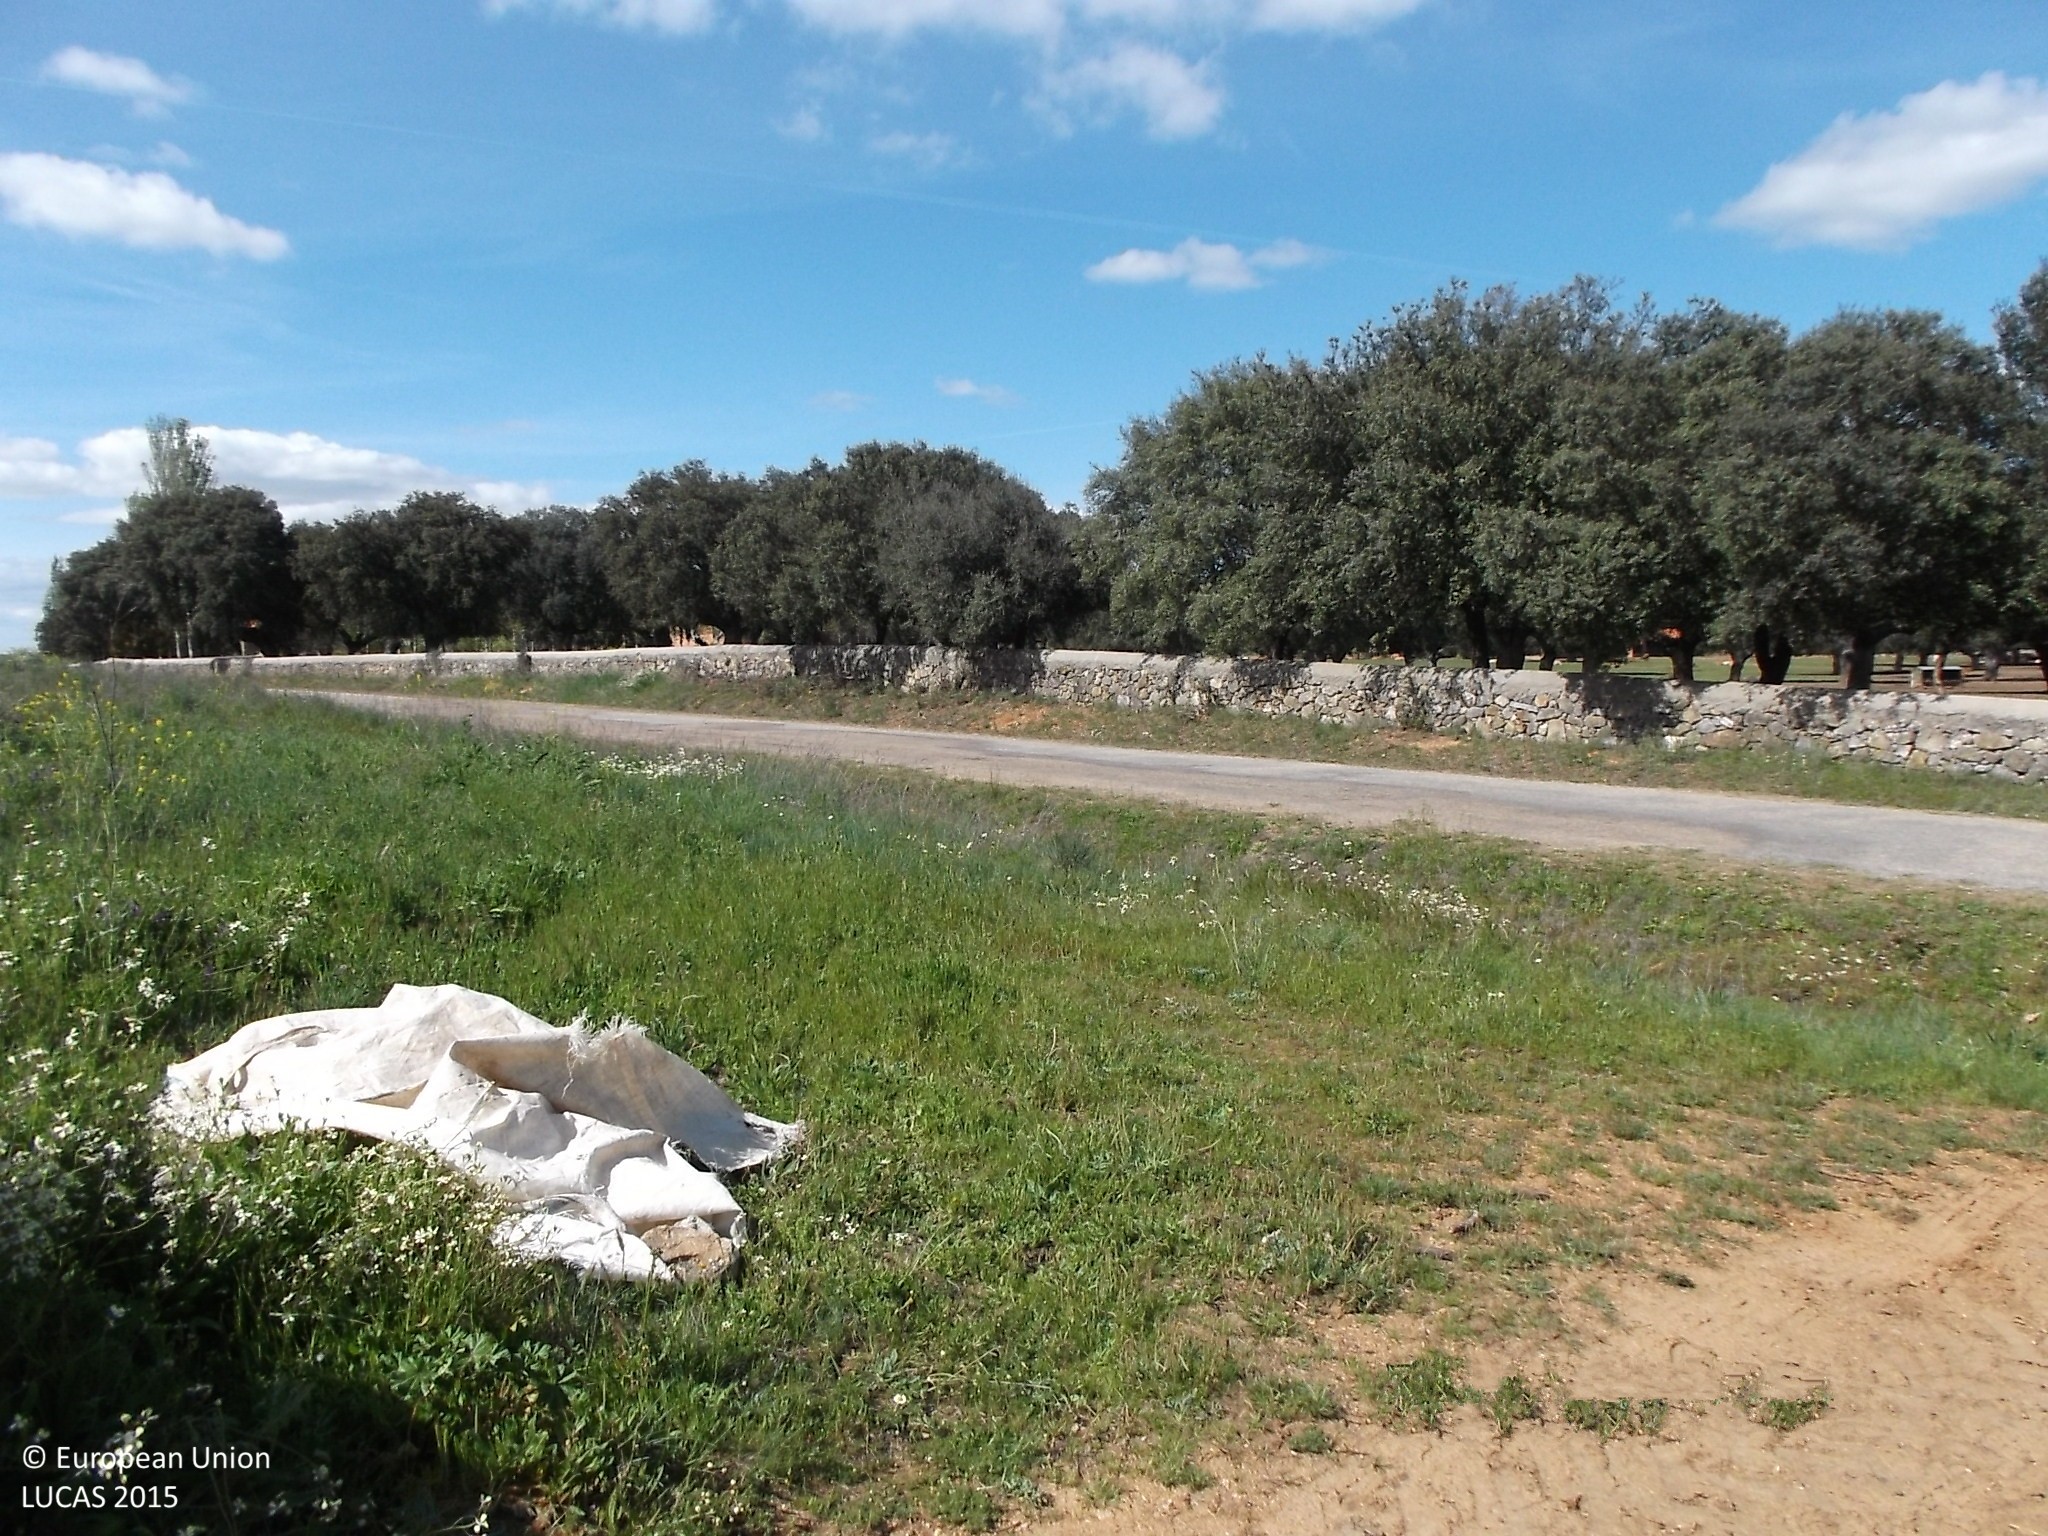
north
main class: Woodland
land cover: Broadleaved woodland
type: broadleaved evergreen forest
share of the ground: 25 - 50 %
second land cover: Grassland without tree/shrub cover
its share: 50 - 75 %
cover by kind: herbaceous plants 70 %, broadleaved forest trees 30 %
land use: Forestry
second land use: Agriculture (excluding fallow land and kitchen gardens)
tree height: > 5 m
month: April
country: ES
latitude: 40.9374
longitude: -5.9627
